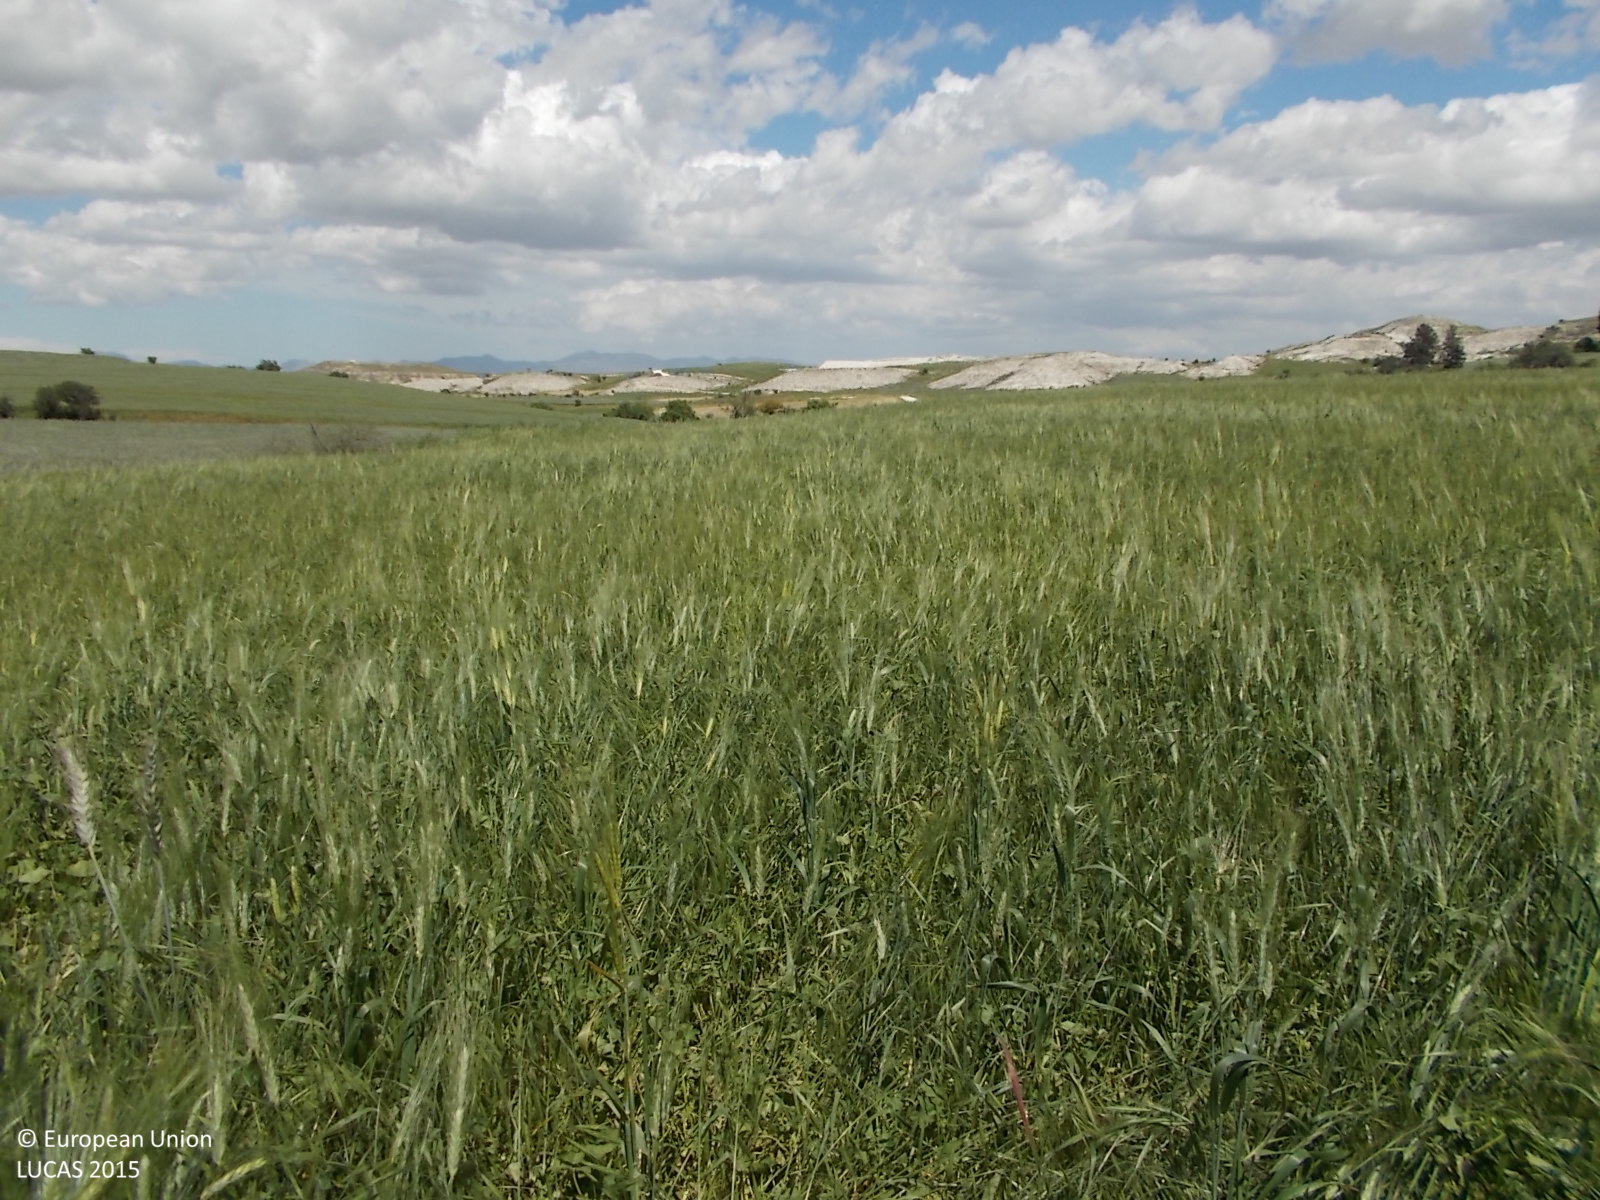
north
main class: Cropland
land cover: Mixed cereals for fodder
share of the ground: > 75 %
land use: Agriculture (excluding fallow land and kitchen gardens)
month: April
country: CY
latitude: 35.0144
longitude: 33.5265
